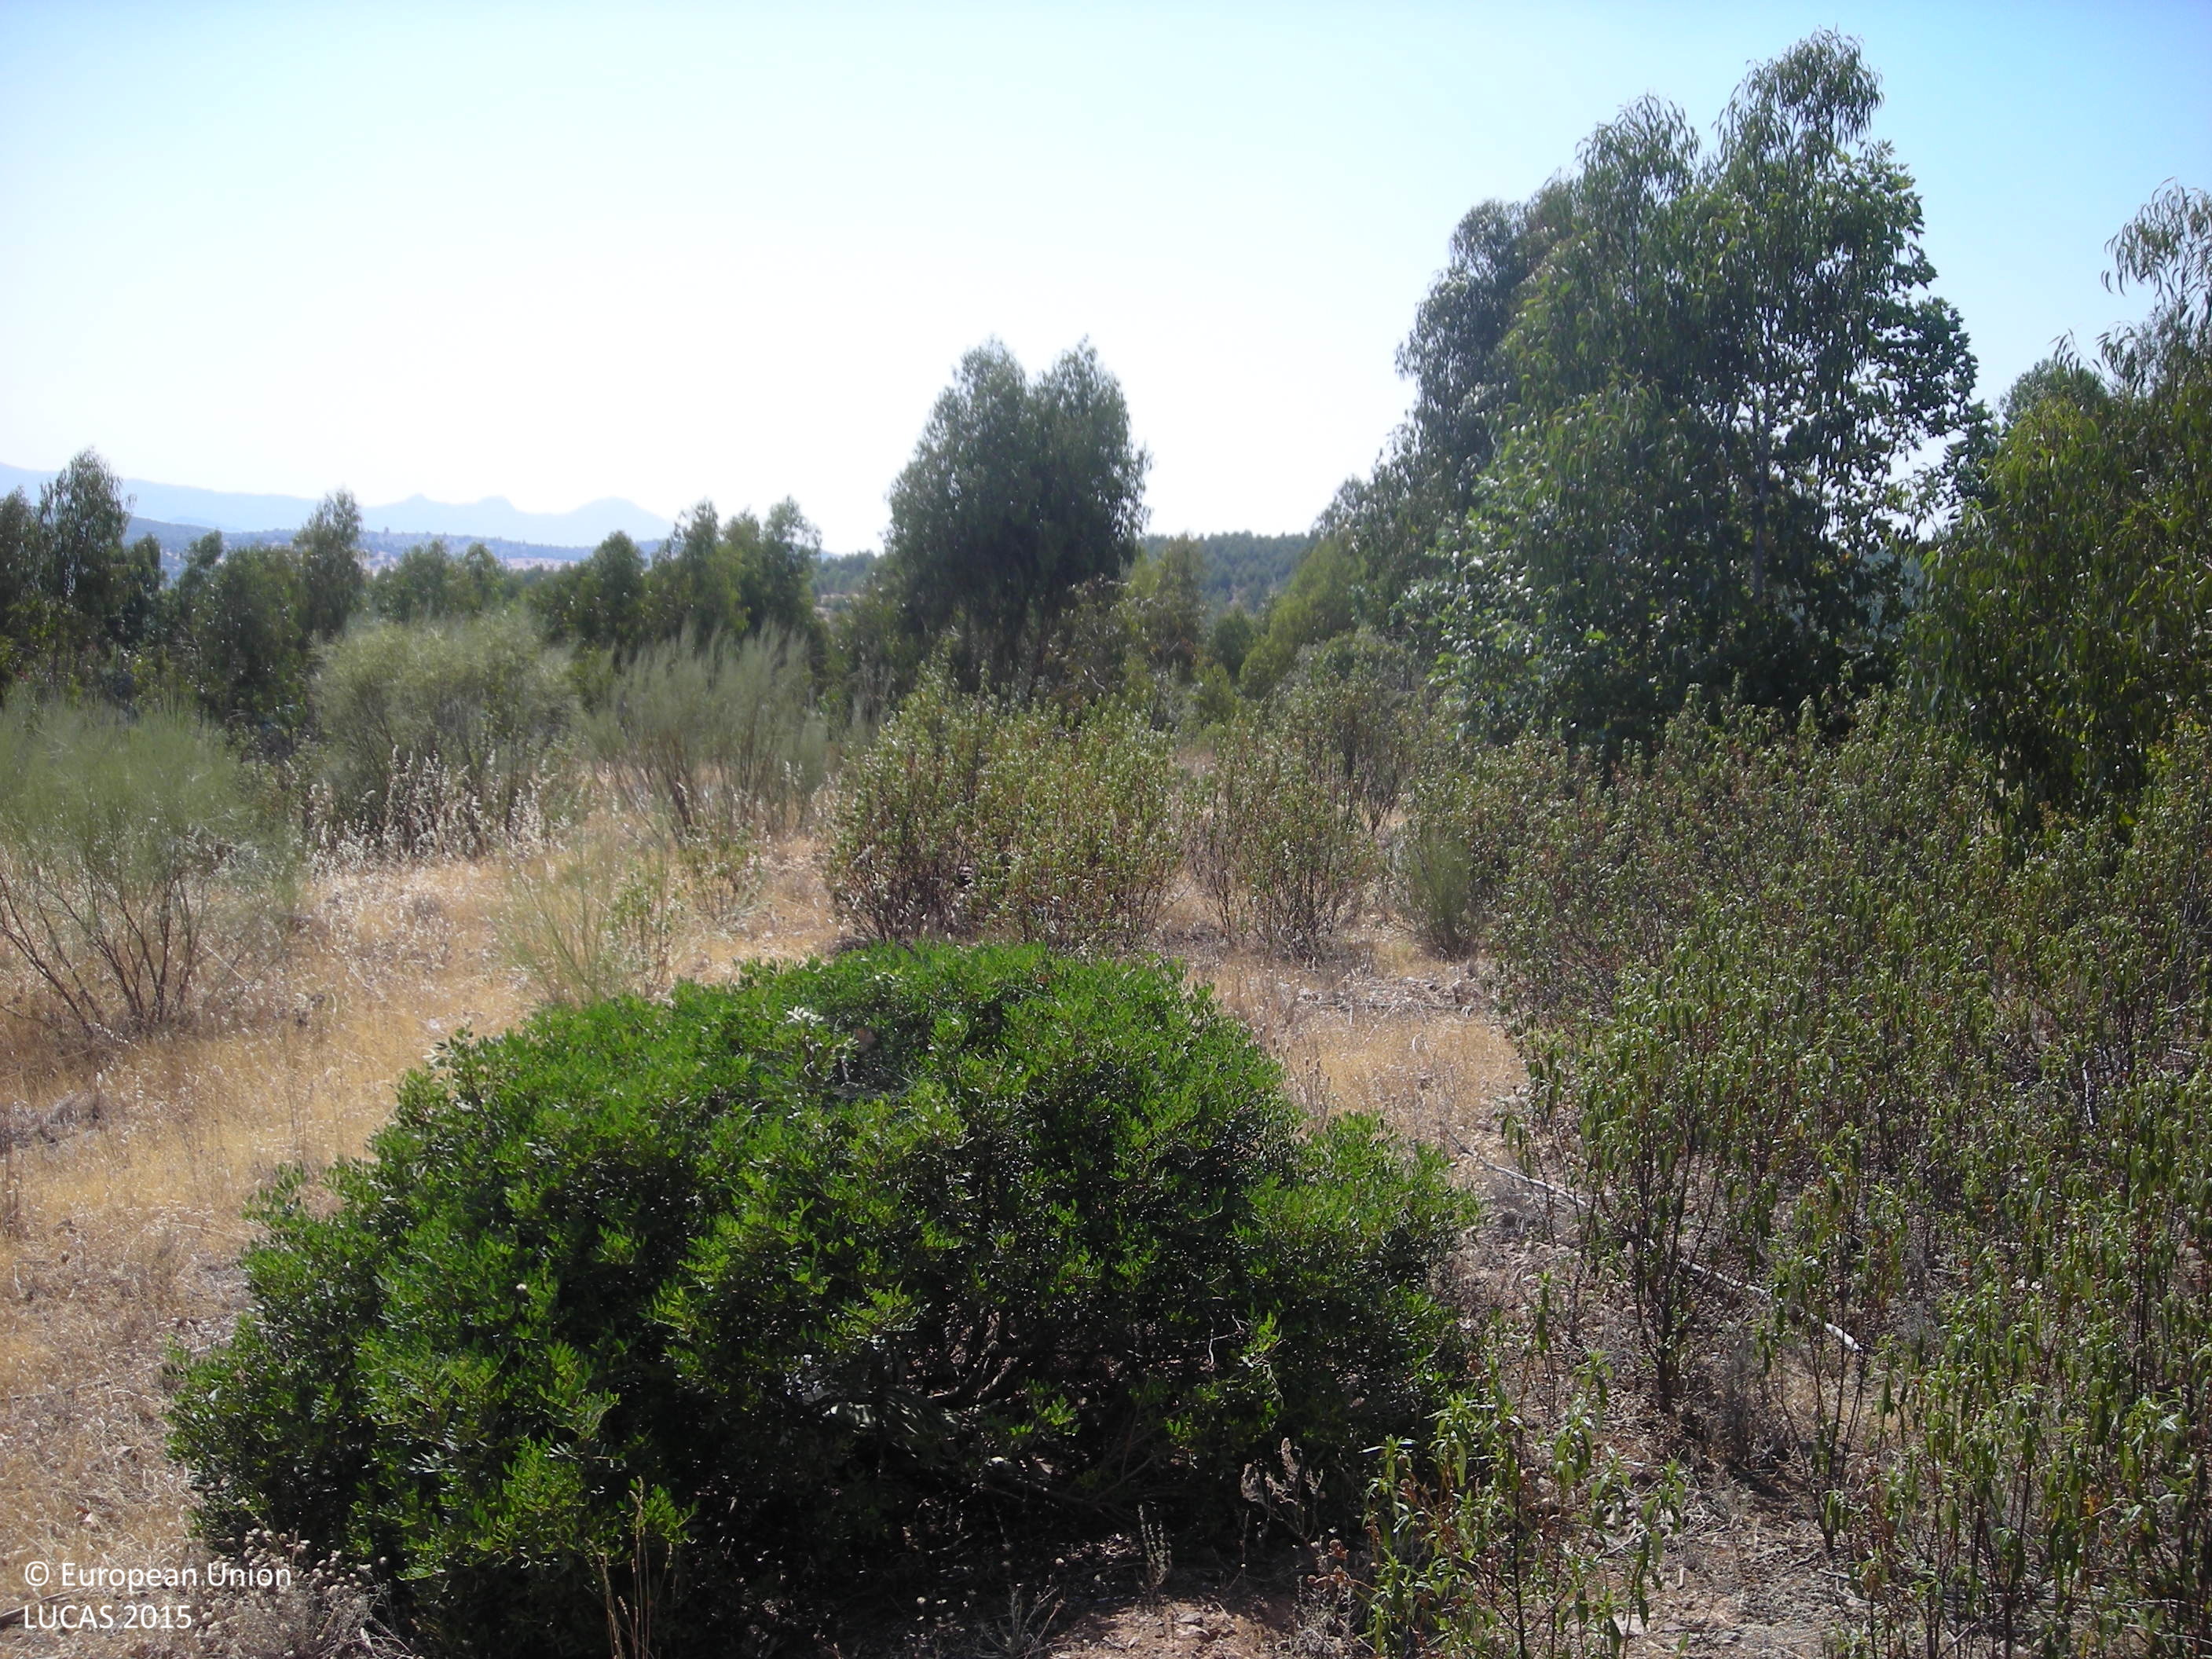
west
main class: Shrubland
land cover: Shrubland with sparse tree cover
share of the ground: > 75 %
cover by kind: shrubs 95 %, broadleaved forest trees 5 %
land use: Semi-natural and natural areas not in use
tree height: > 5 m
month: June
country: ES
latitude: 38.5794
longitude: -5.8726
